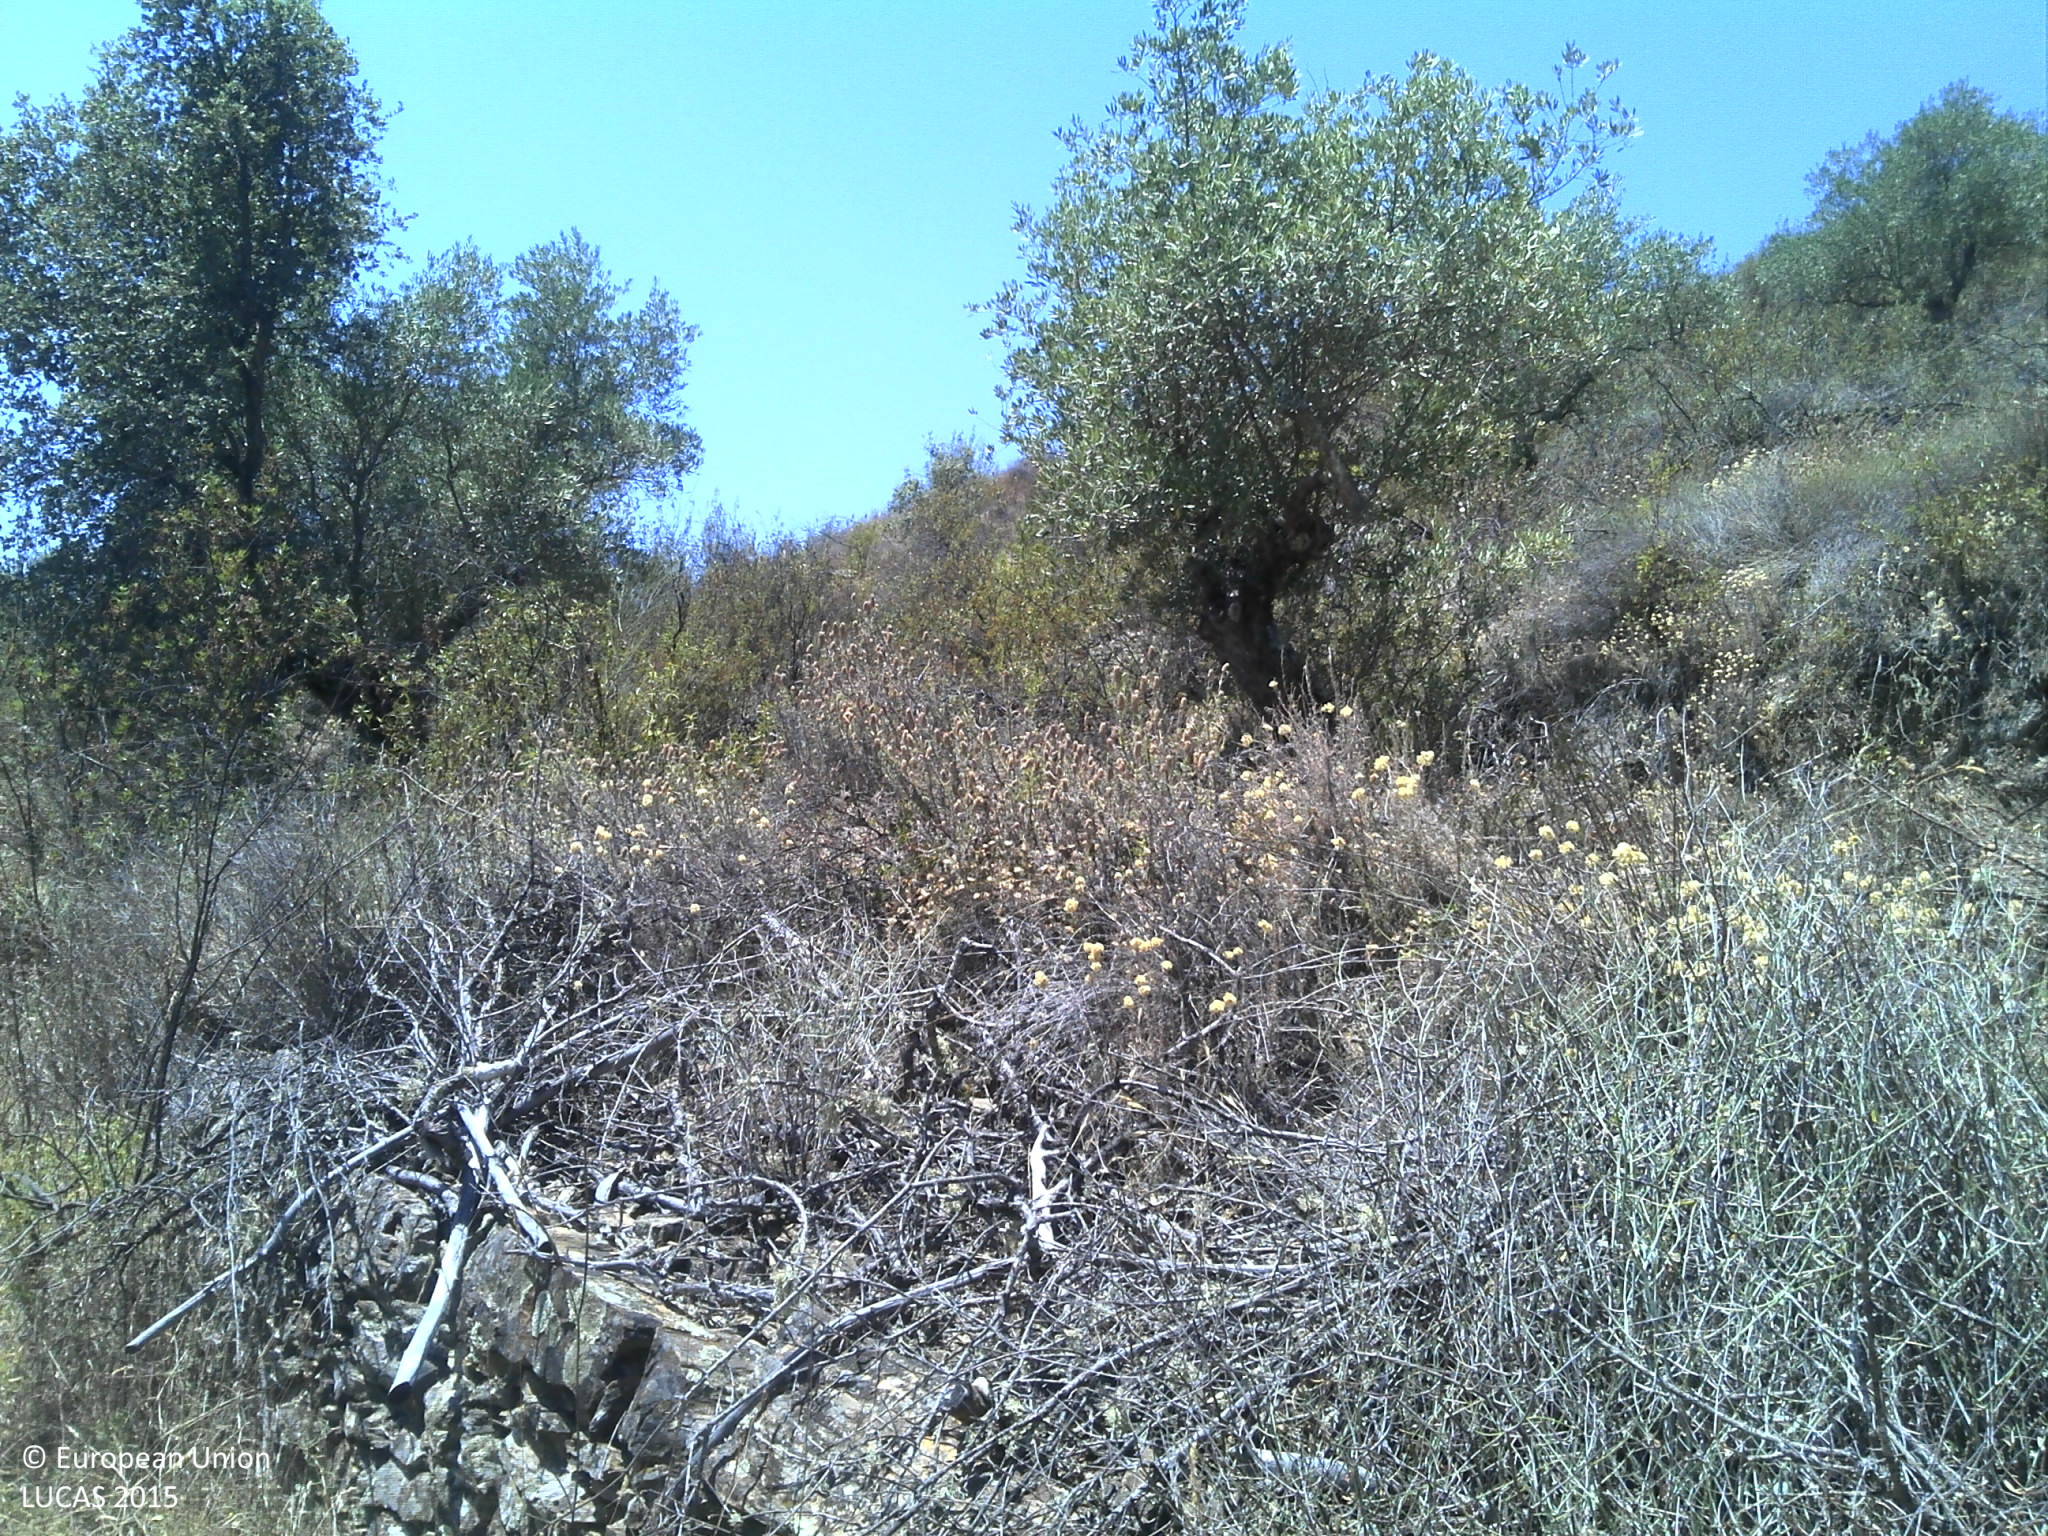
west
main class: Cropland
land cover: Olive groves
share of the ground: 25 - 50 %
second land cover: Shrubland without tree cover
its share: 25 - 50 %
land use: Agriculture (excluding fallow land and kitchen gardens)
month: July
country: PT
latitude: 39.7431
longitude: -7.5450
